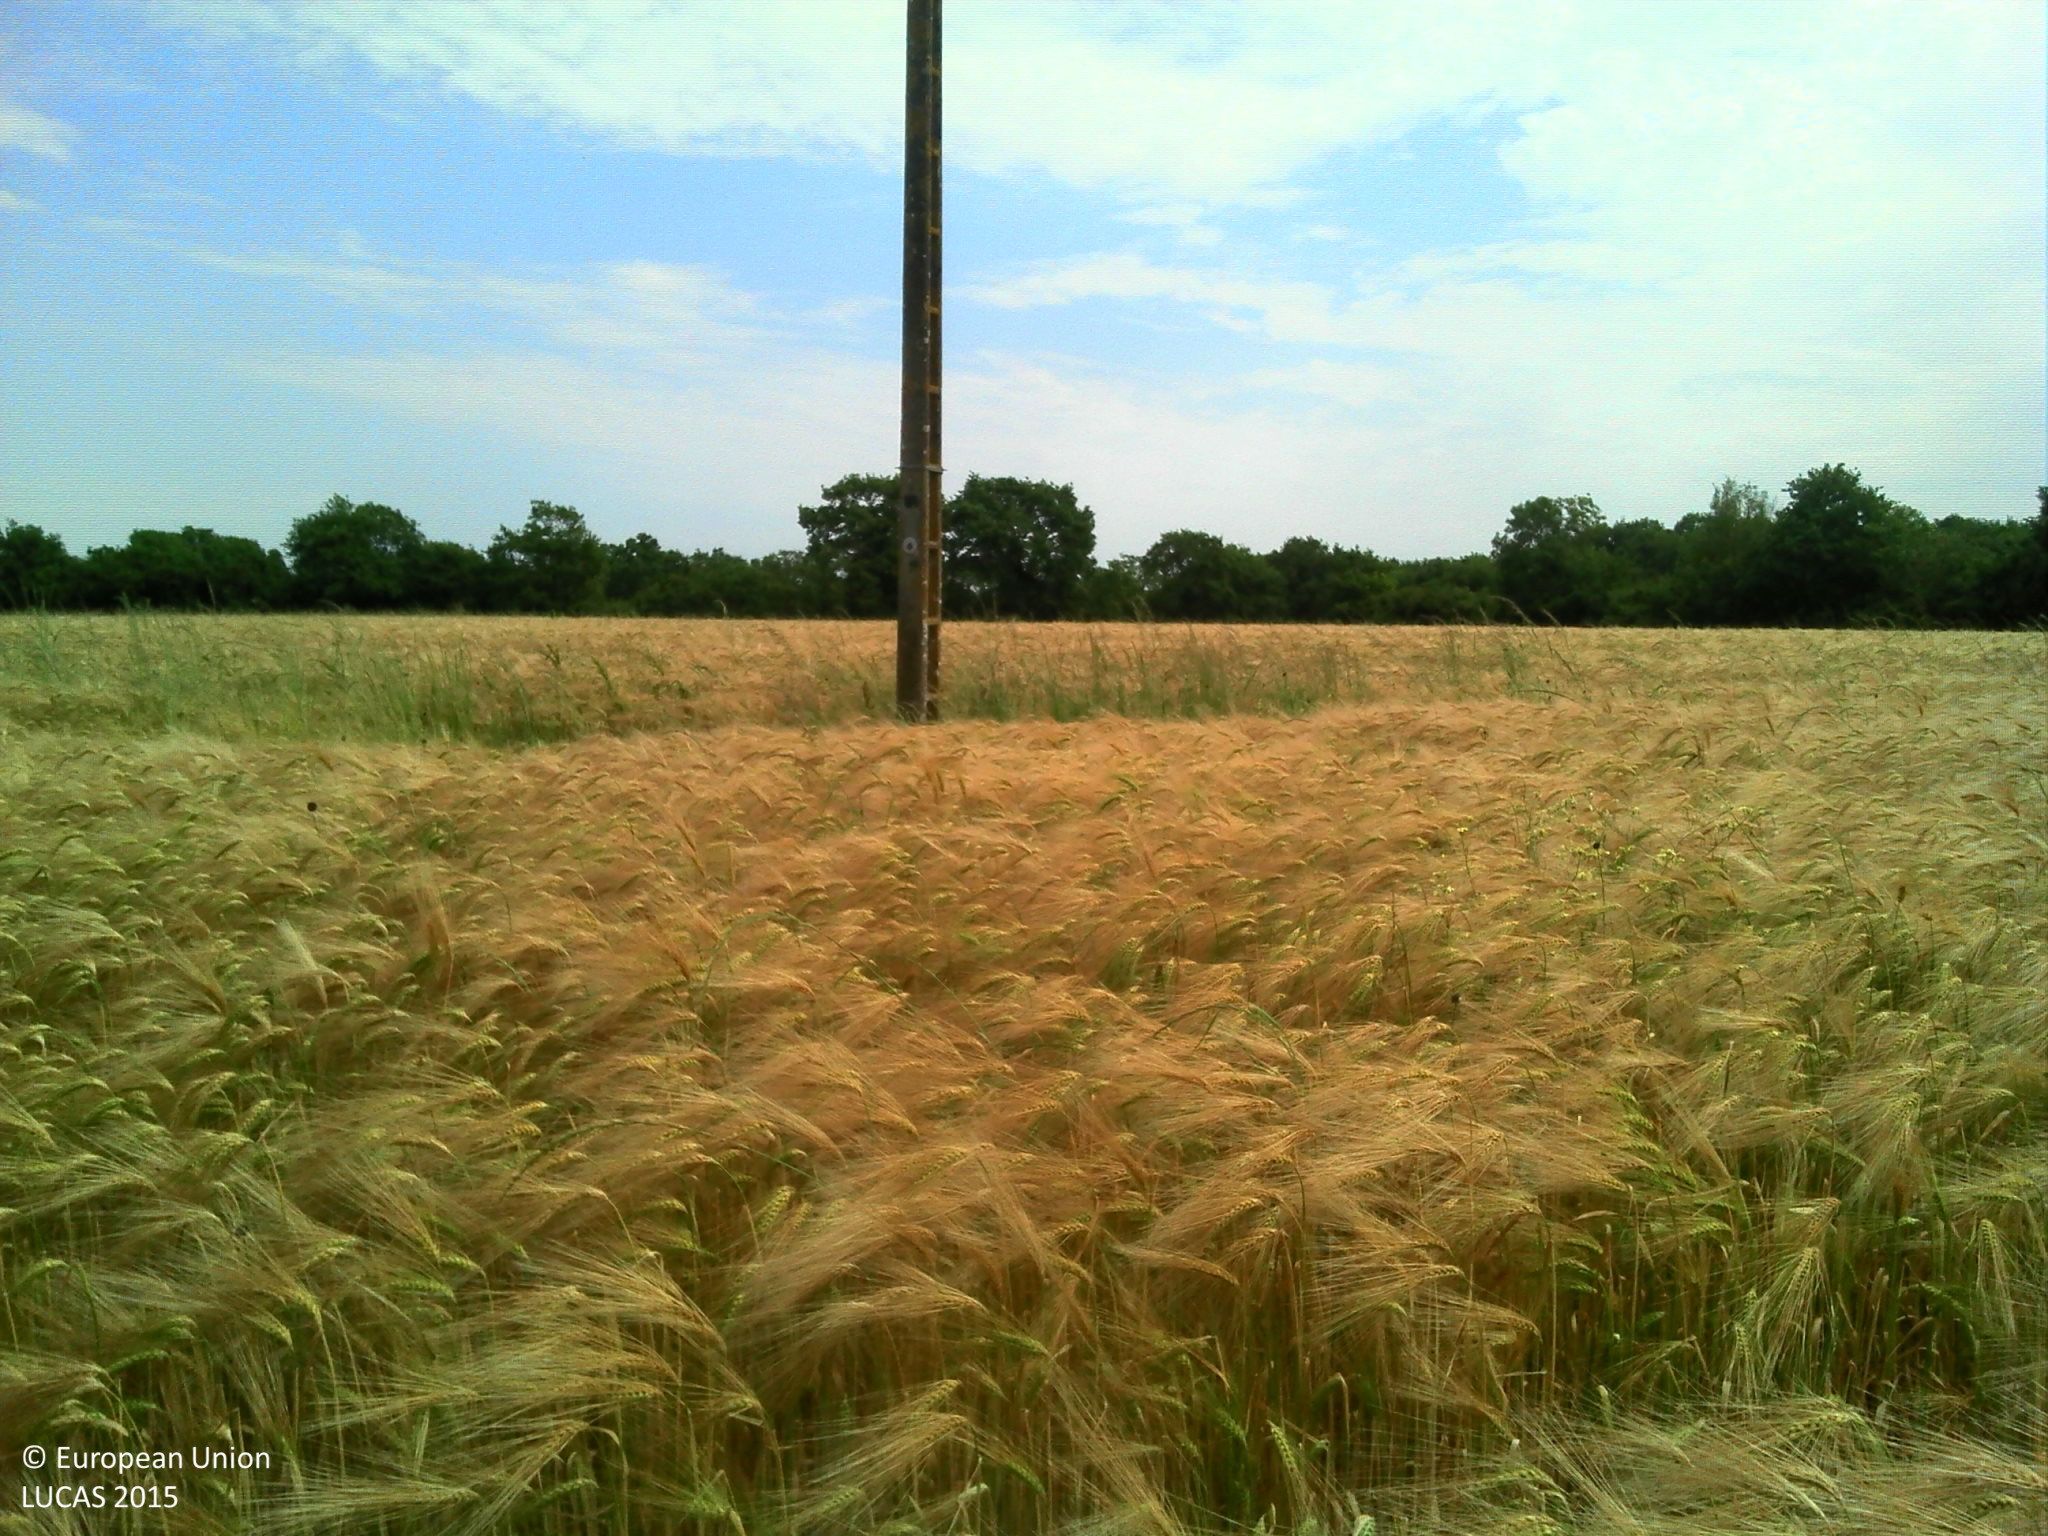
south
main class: Cropland
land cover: Barley
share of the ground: > 75 %
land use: Agriculture (excluding fallow land and kitchen gardens)
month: June
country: FR
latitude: 46.7907
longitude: -1.7674
